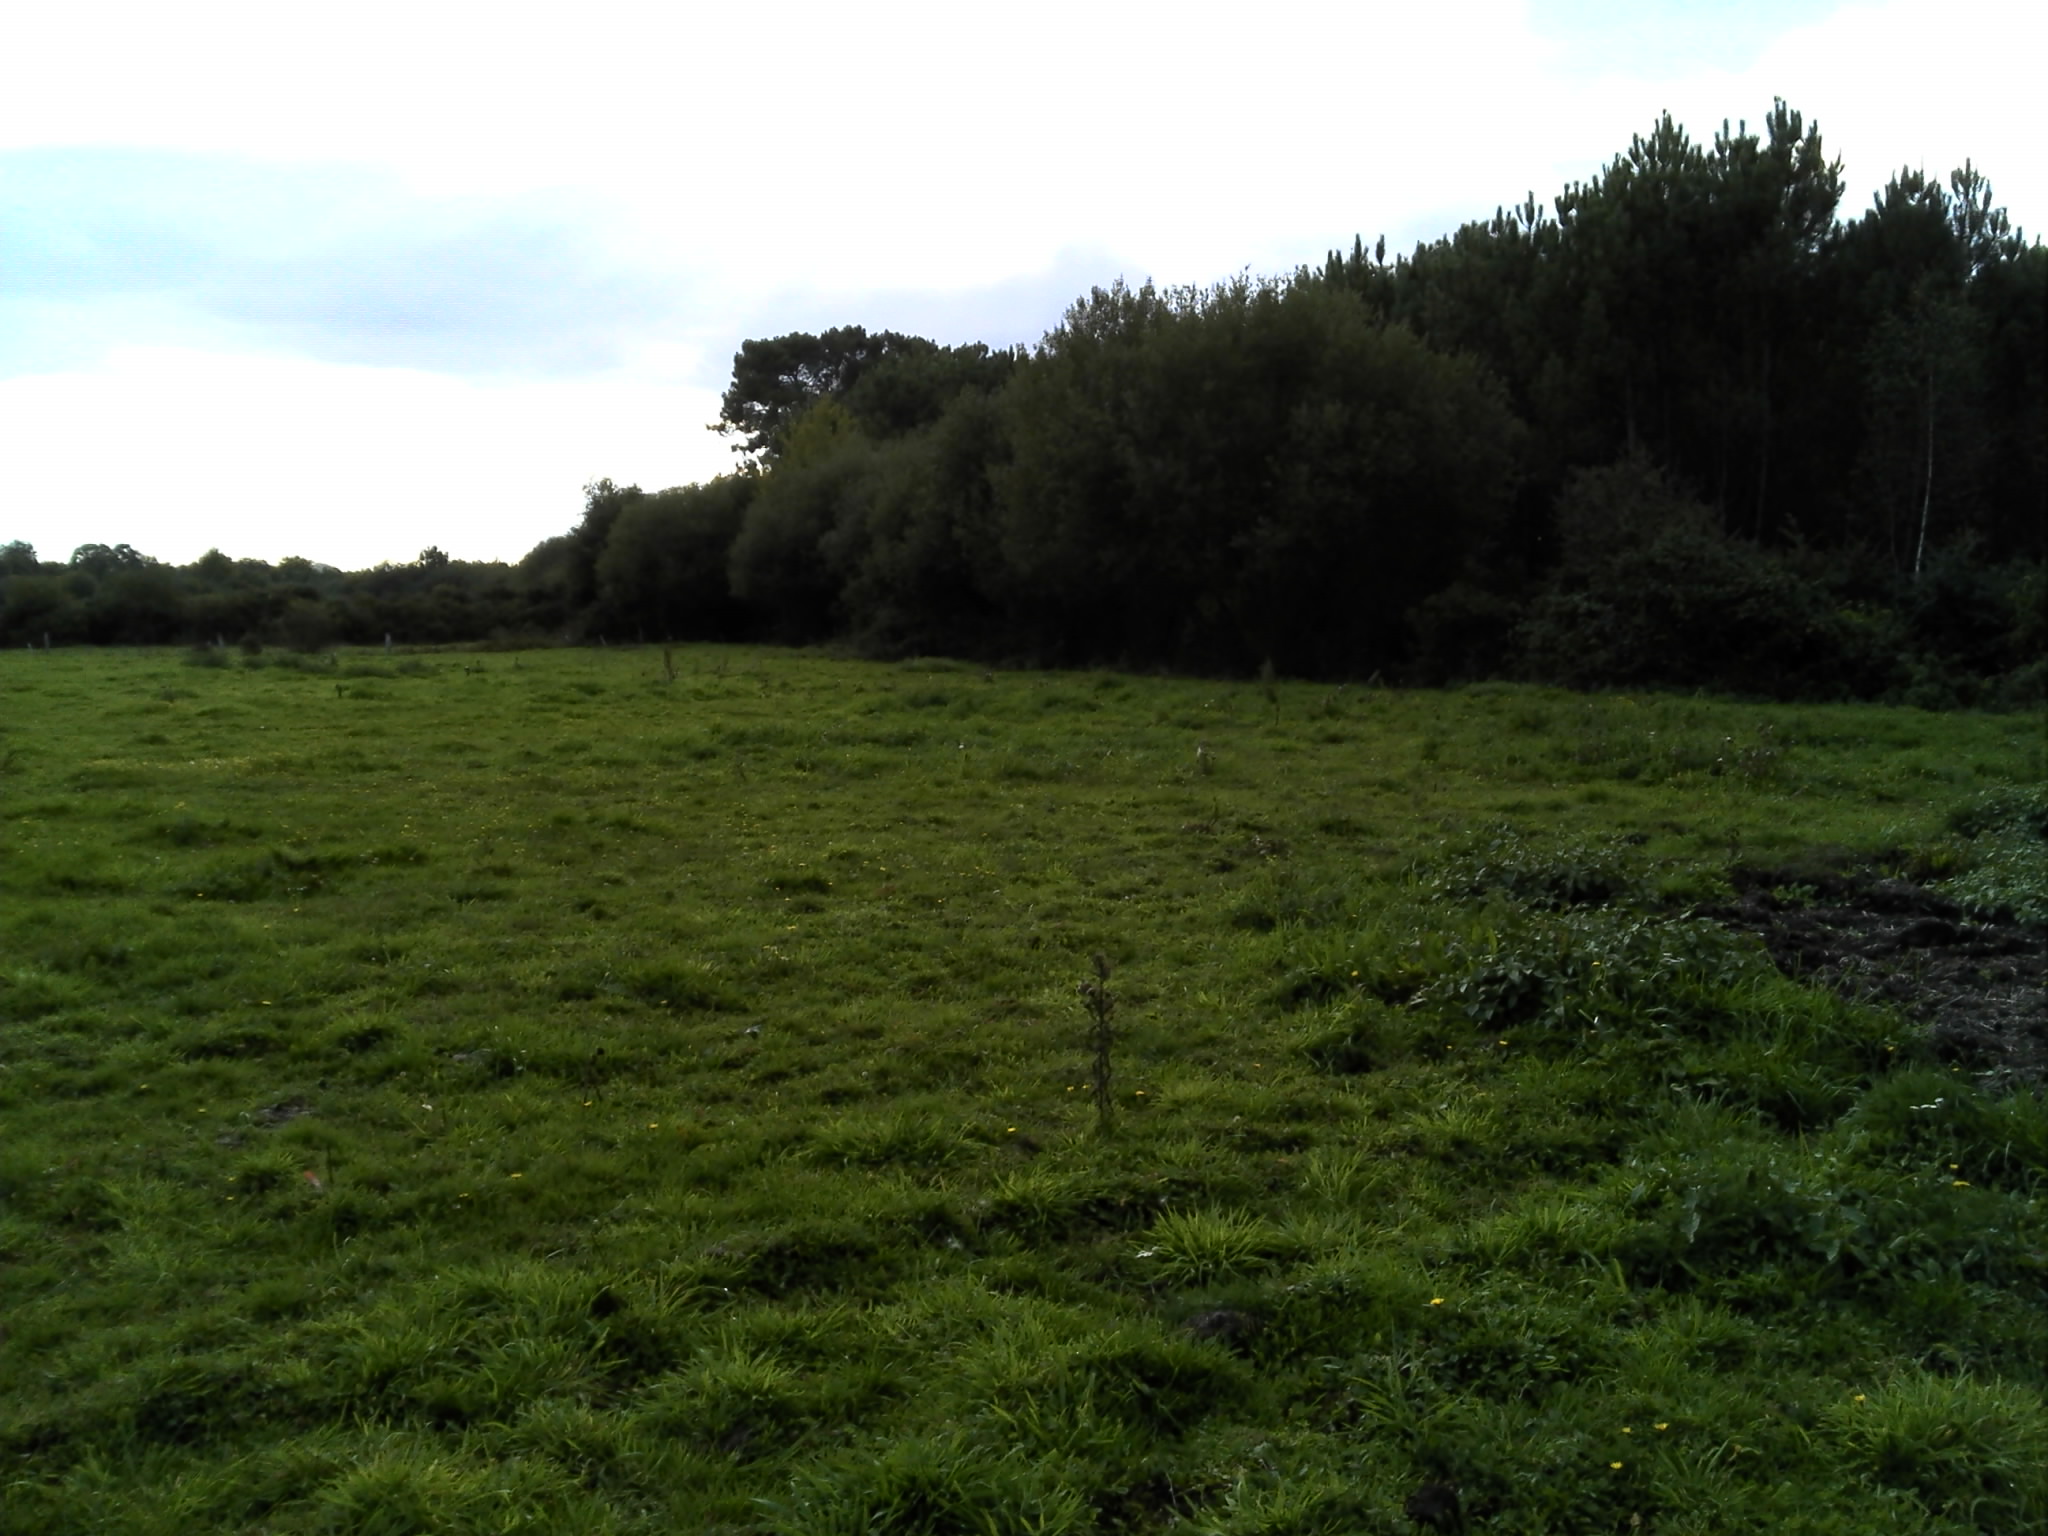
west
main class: Grassland
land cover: Grassland without tree/shrub cover
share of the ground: > 75 %
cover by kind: herbaceous plants 100 %
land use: Agriculture (excluding fallow land and kitchen gardens)
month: October
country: FR
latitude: 47.8265
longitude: 0.0482
